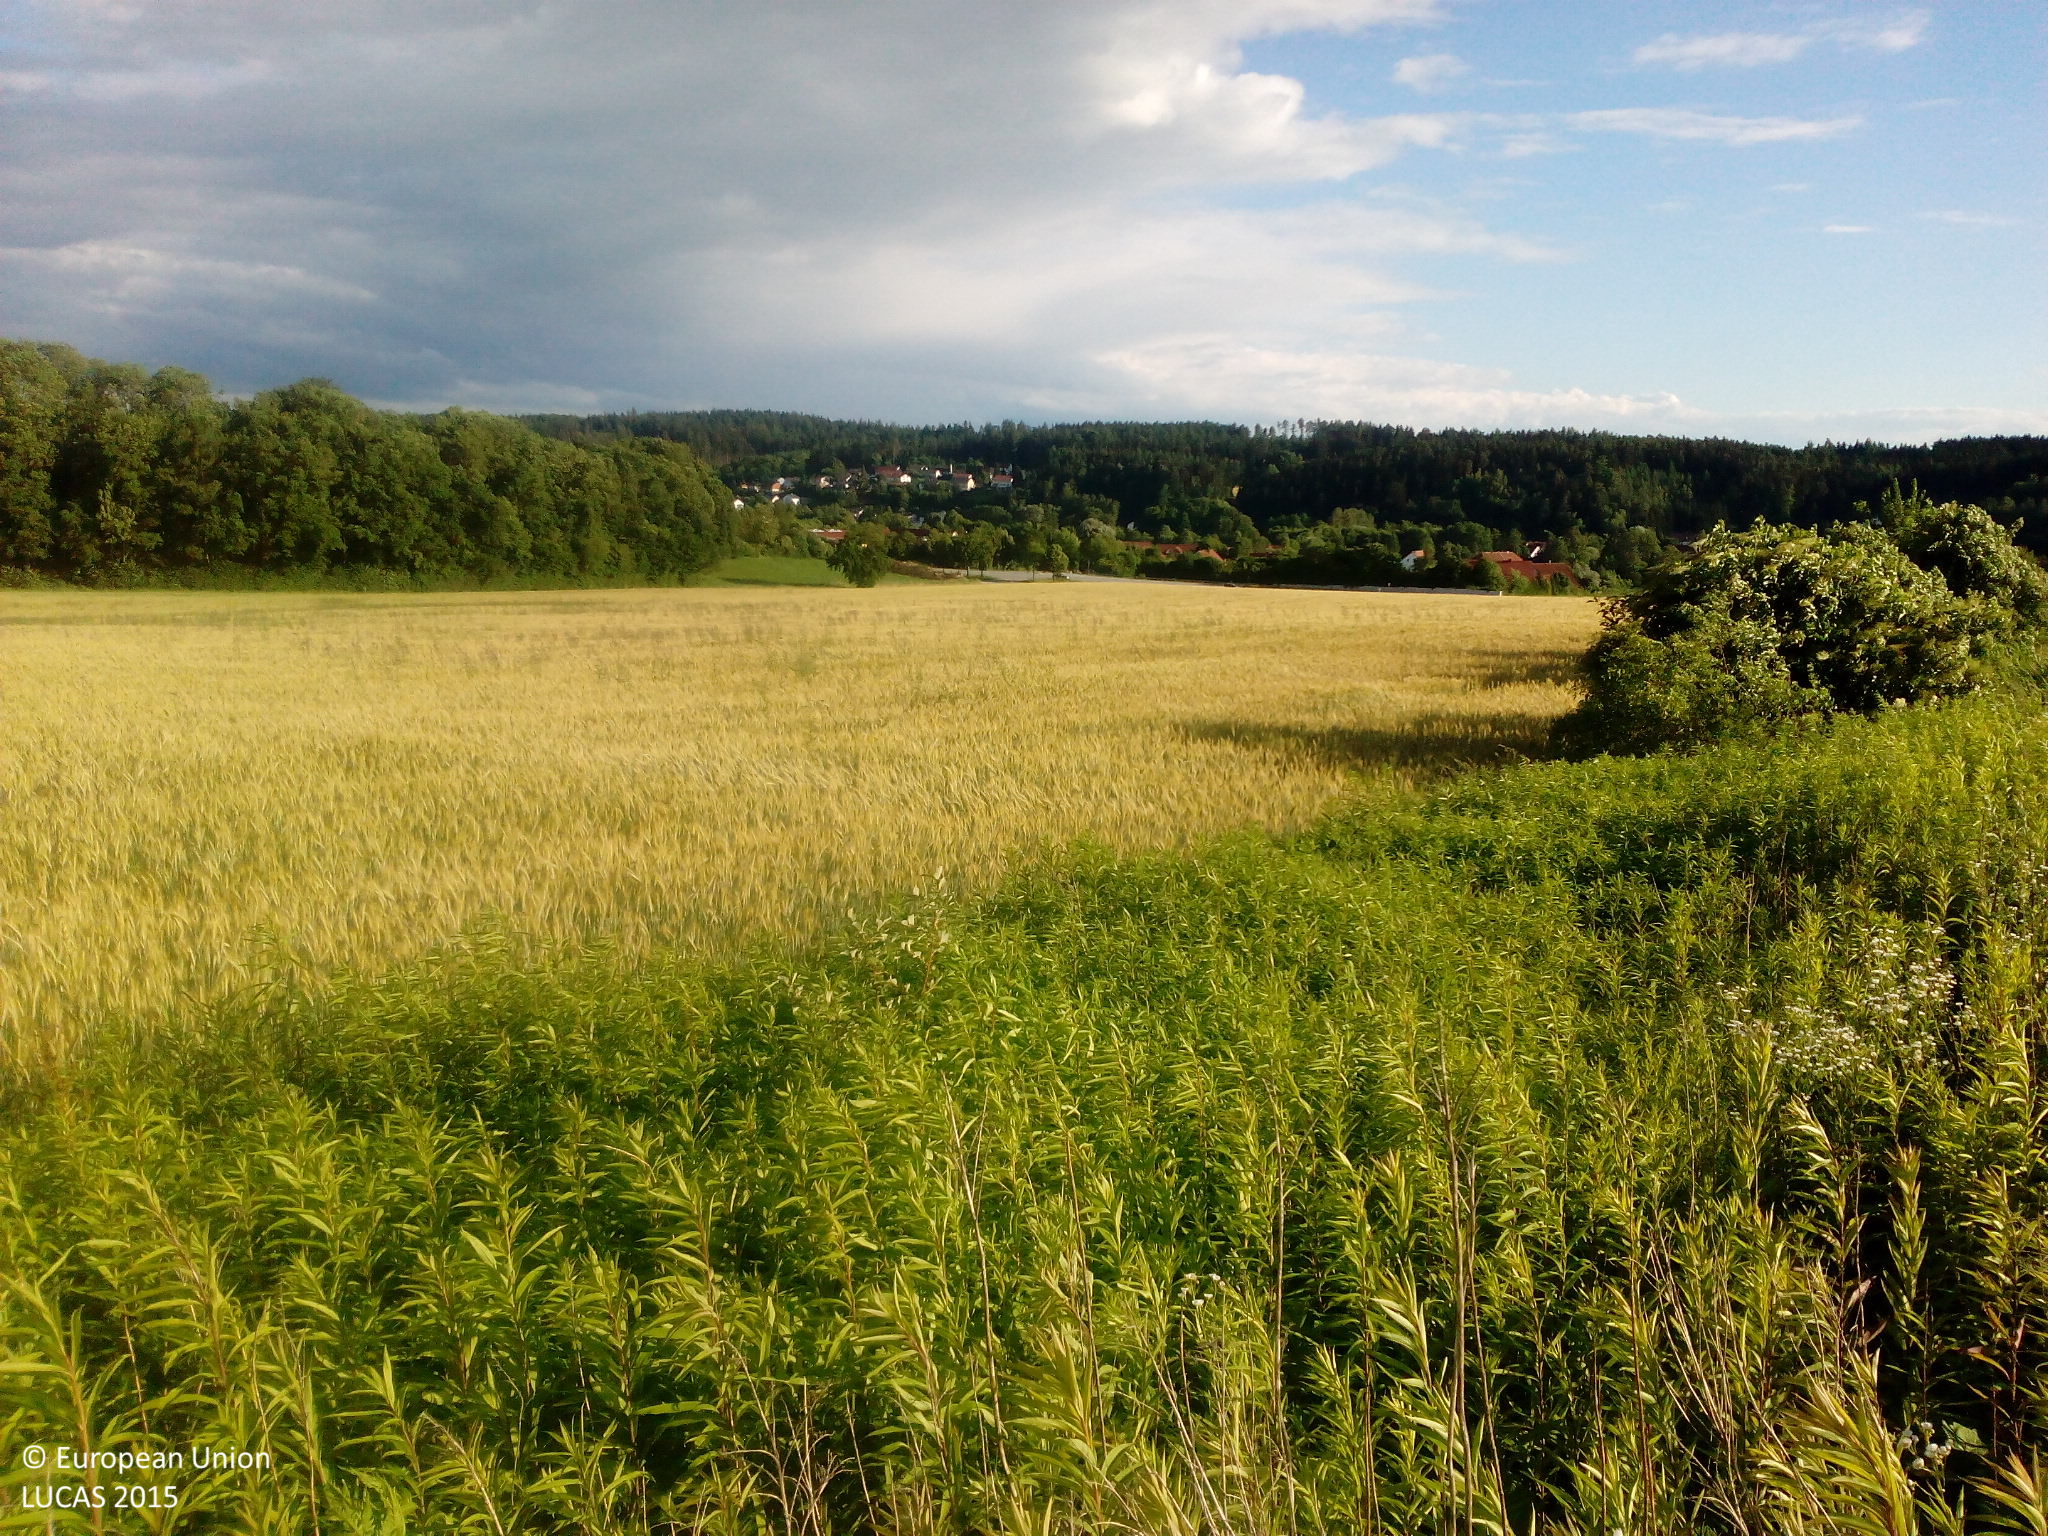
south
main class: Grassland
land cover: Spontaneously vegetated surfaces
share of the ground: 10 - 25 %
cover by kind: unconsolidated bare surface 80 %, herbaceous plants 20 %
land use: Mining and quarrying
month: June
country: DE
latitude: 48.5821
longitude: 12.0732
